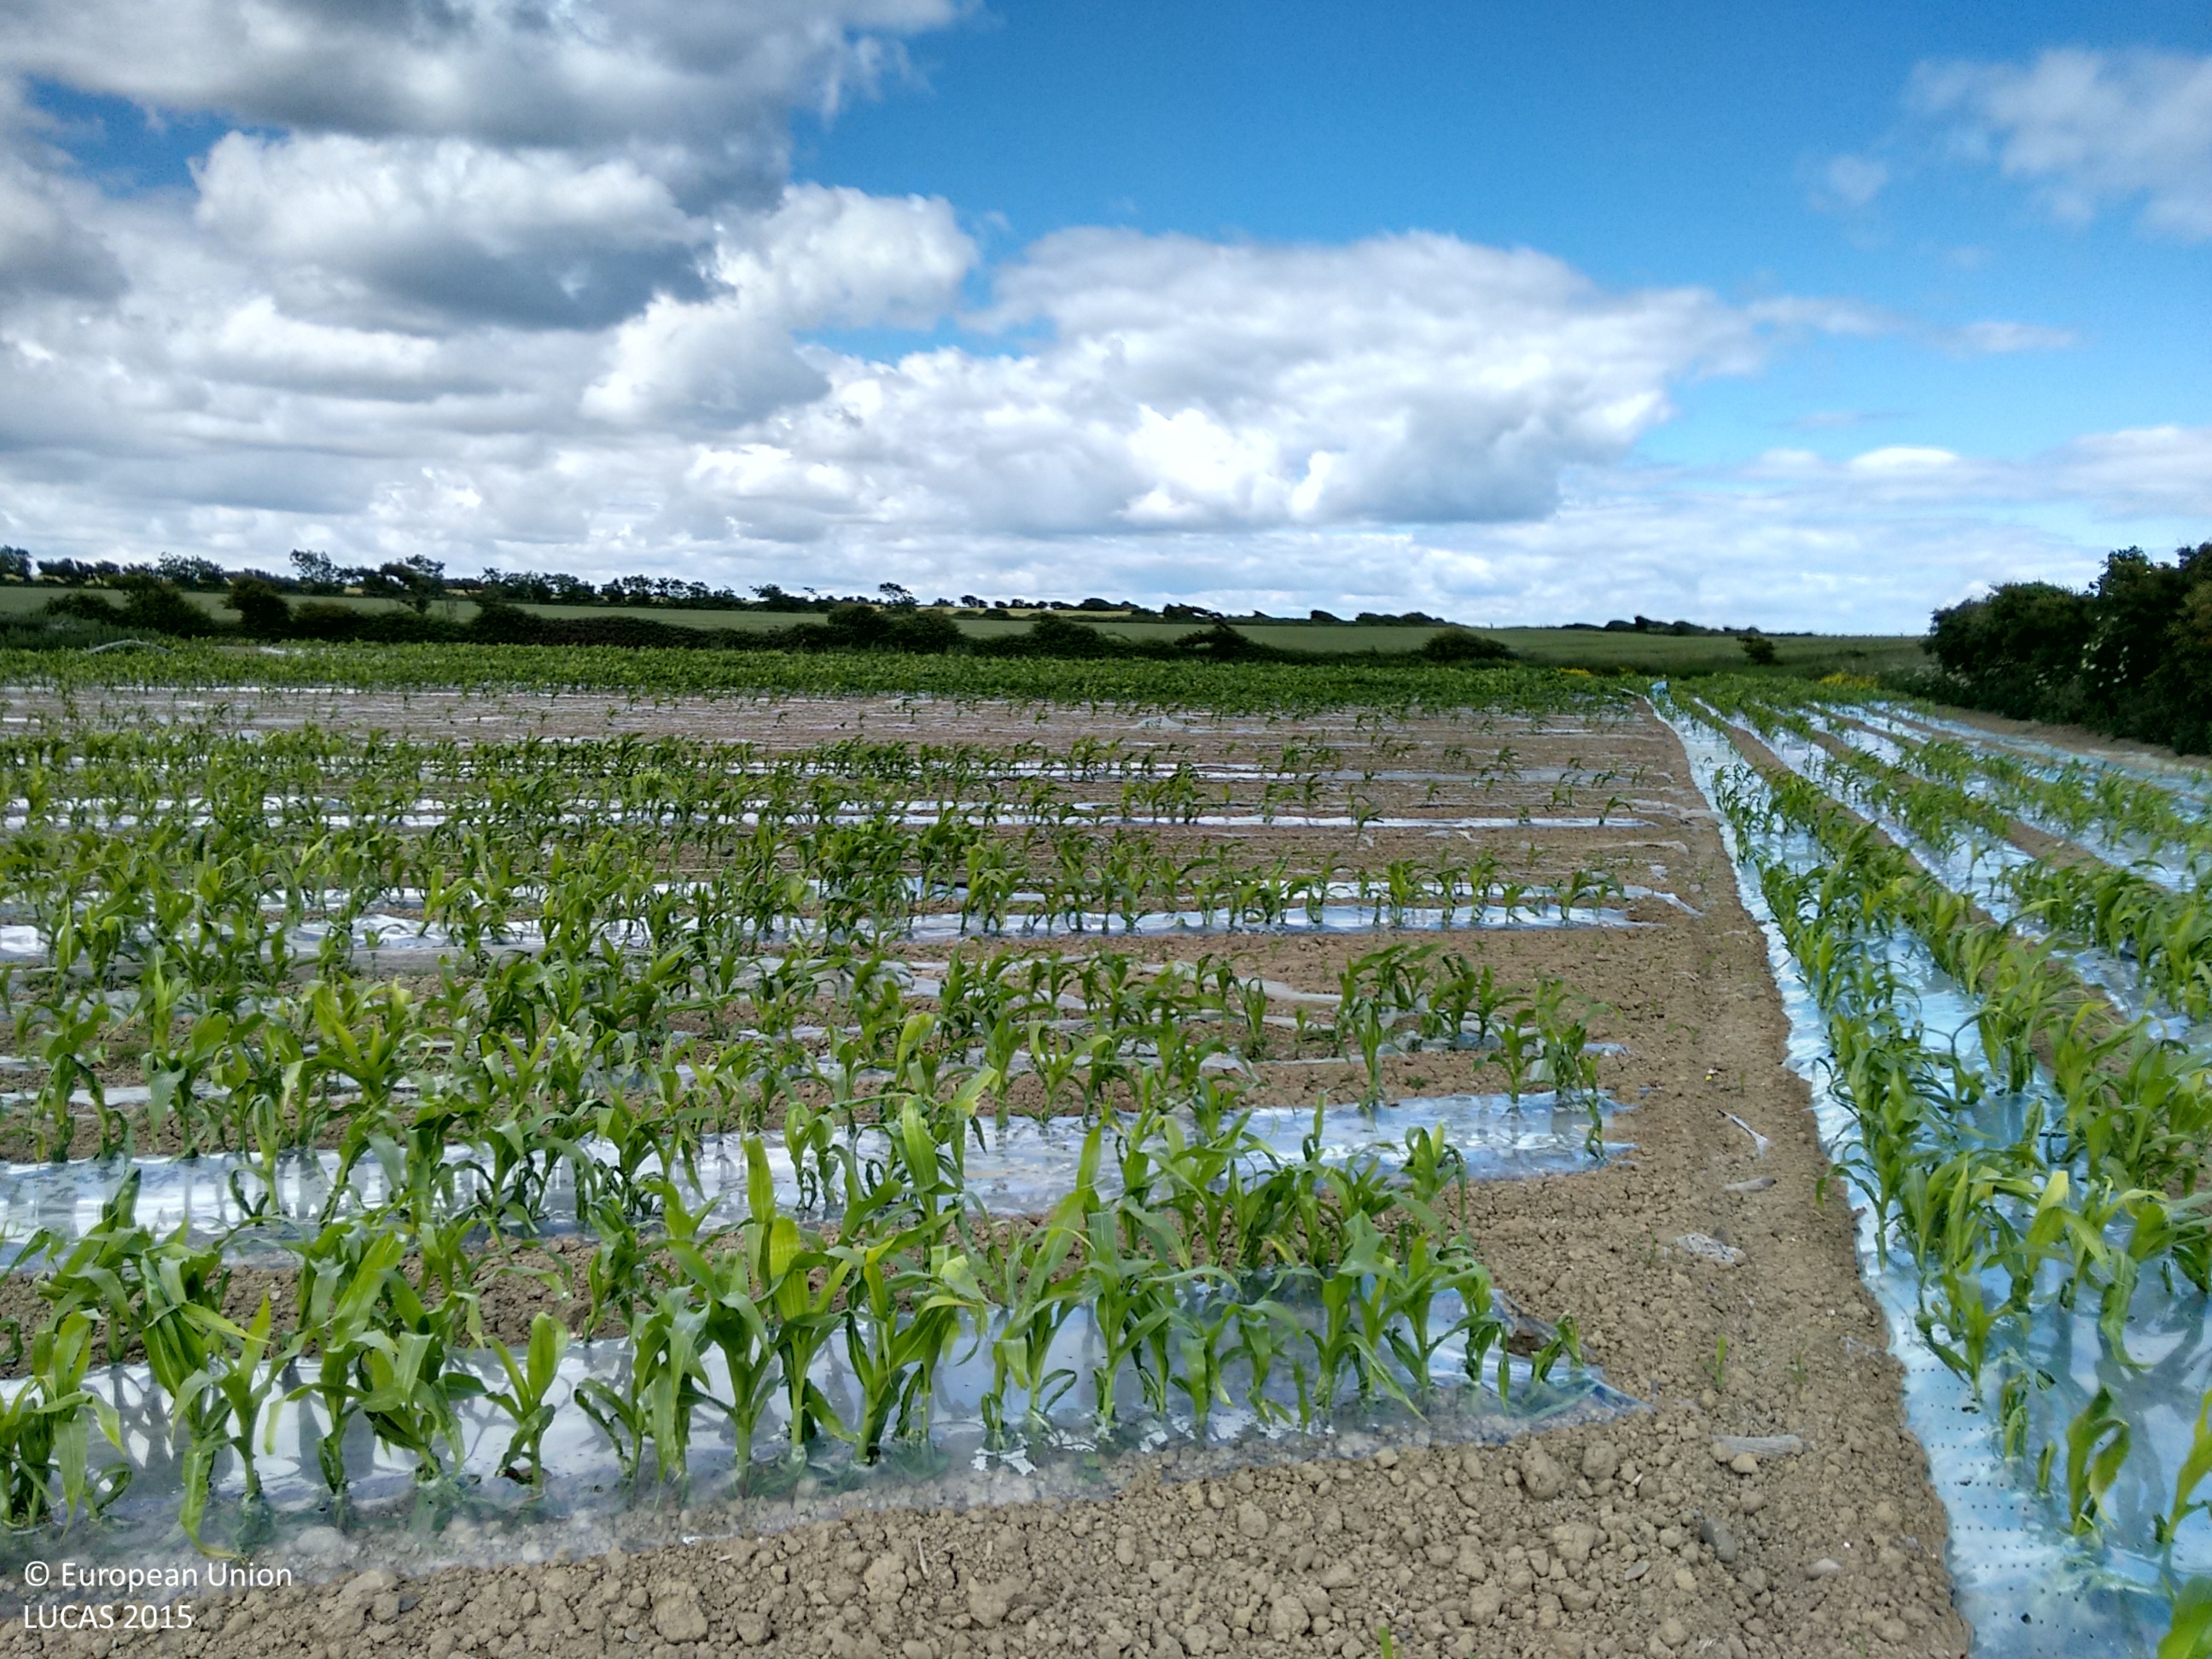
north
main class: Cropland
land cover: Maize
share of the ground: 50 - 75 %
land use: Agriculture (excluding fallow land and kitchen gardens)
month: June
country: IE
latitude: 53.6241
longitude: -6.1896
